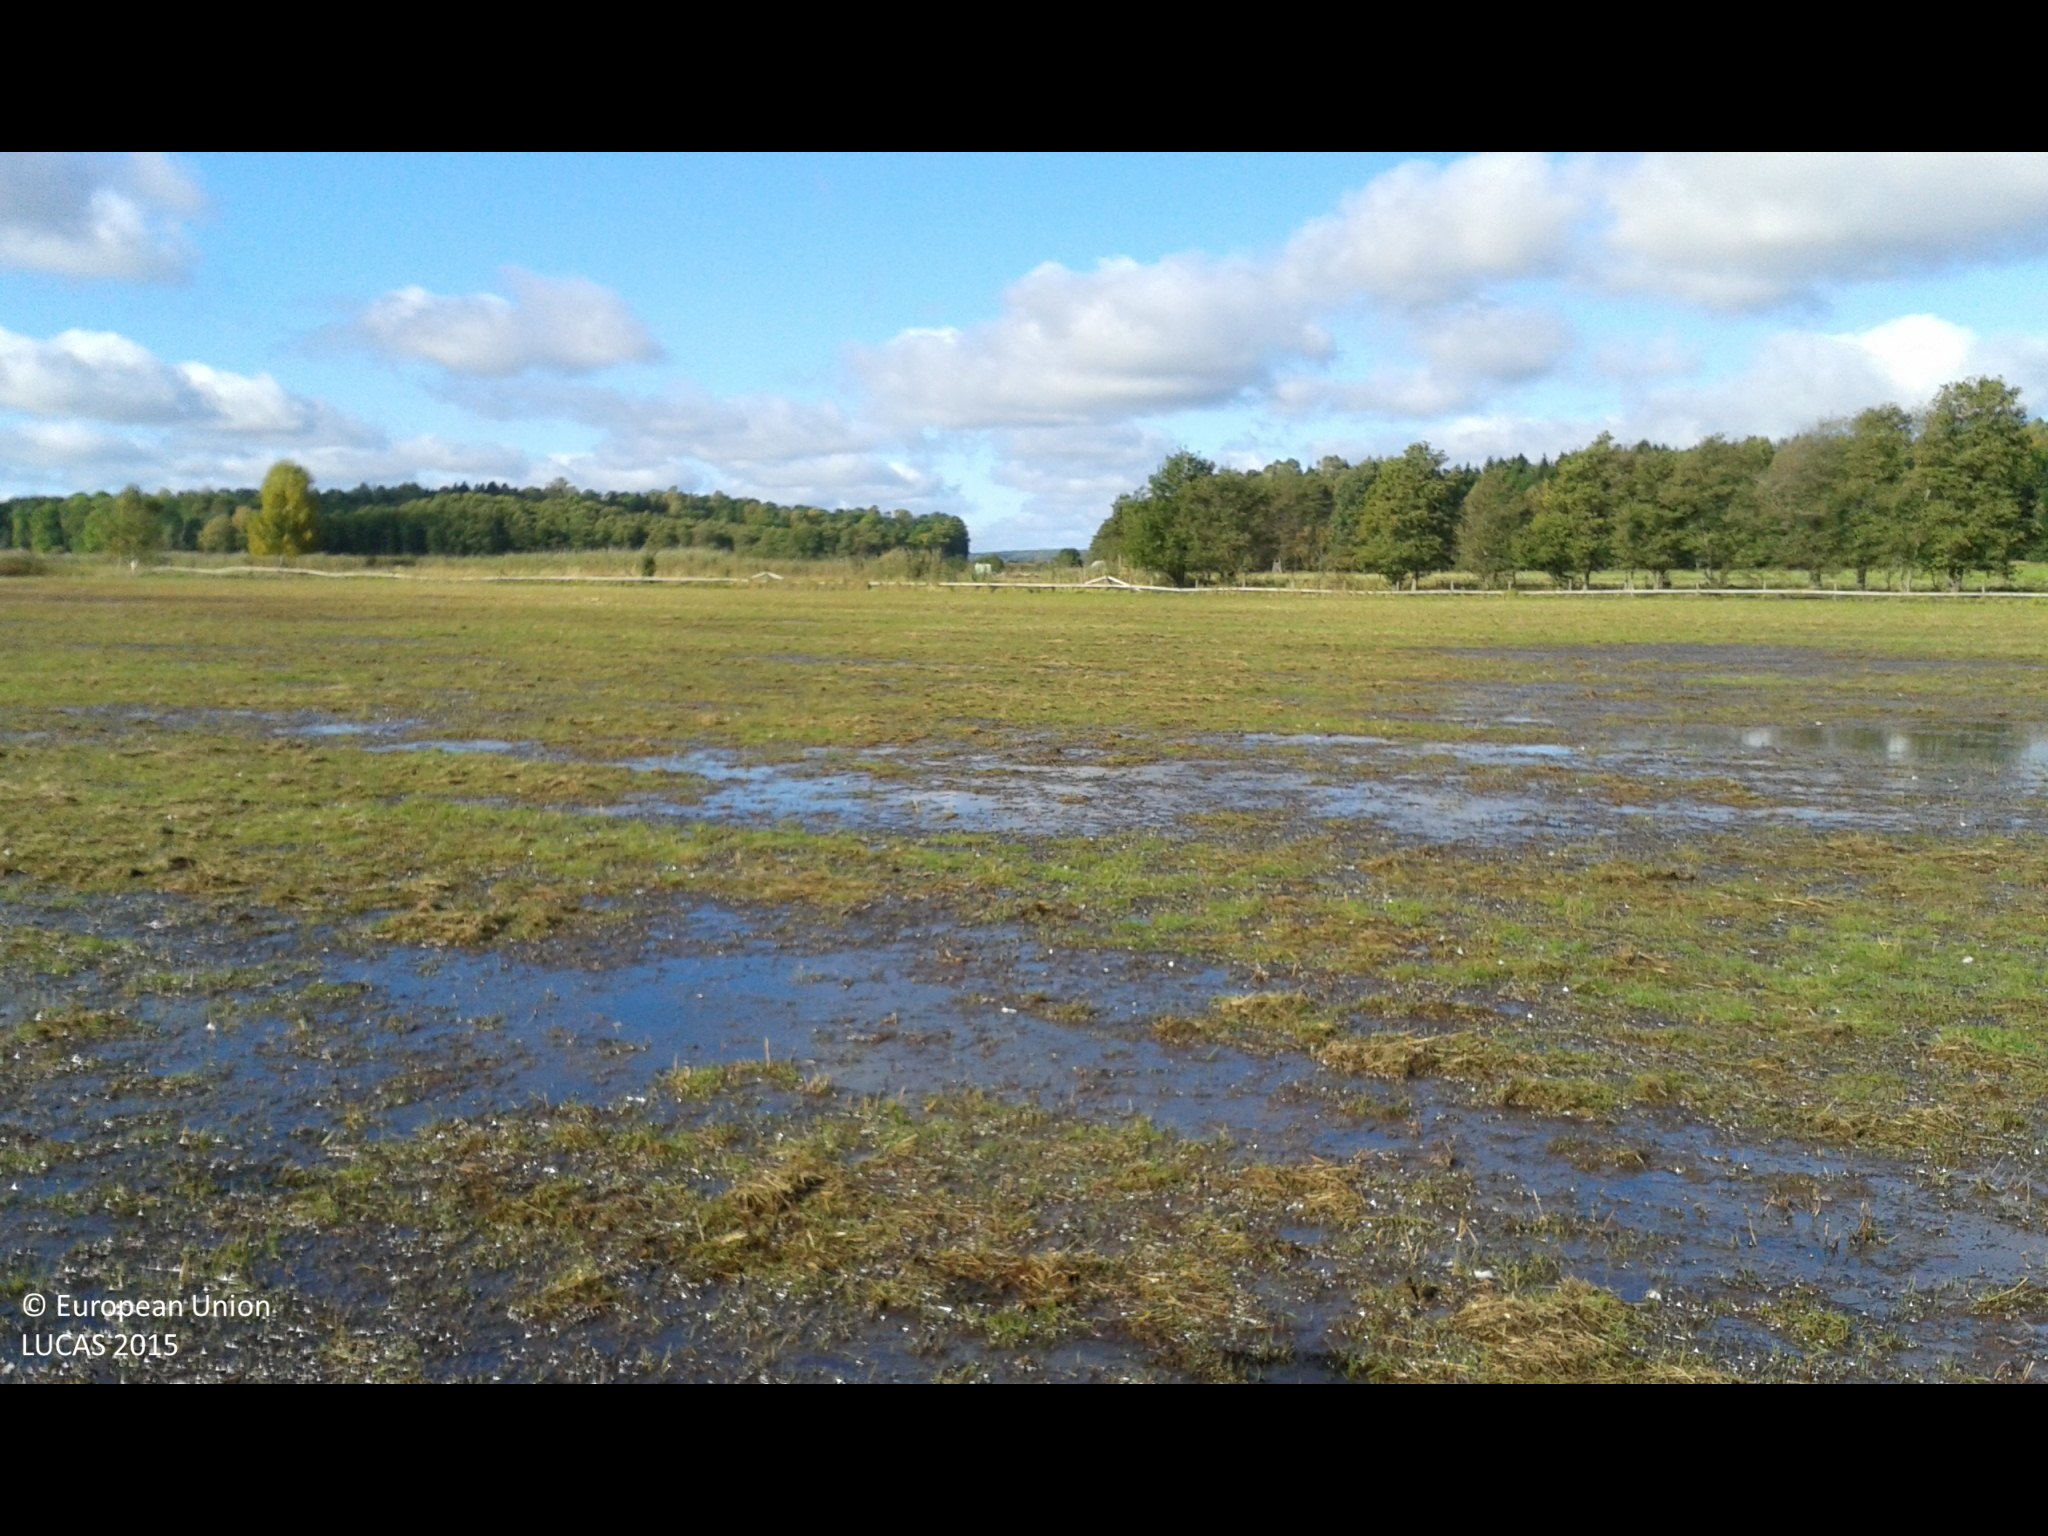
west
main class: Grassland
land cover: Grassland without tree/shrub cover
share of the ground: > 75 %
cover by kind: herbaceous plants 100 %
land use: Agriculture (excluding fallow land and kitchen gardens)
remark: Temporary flooded
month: September
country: SE
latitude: 58.9628
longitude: 17.5969
